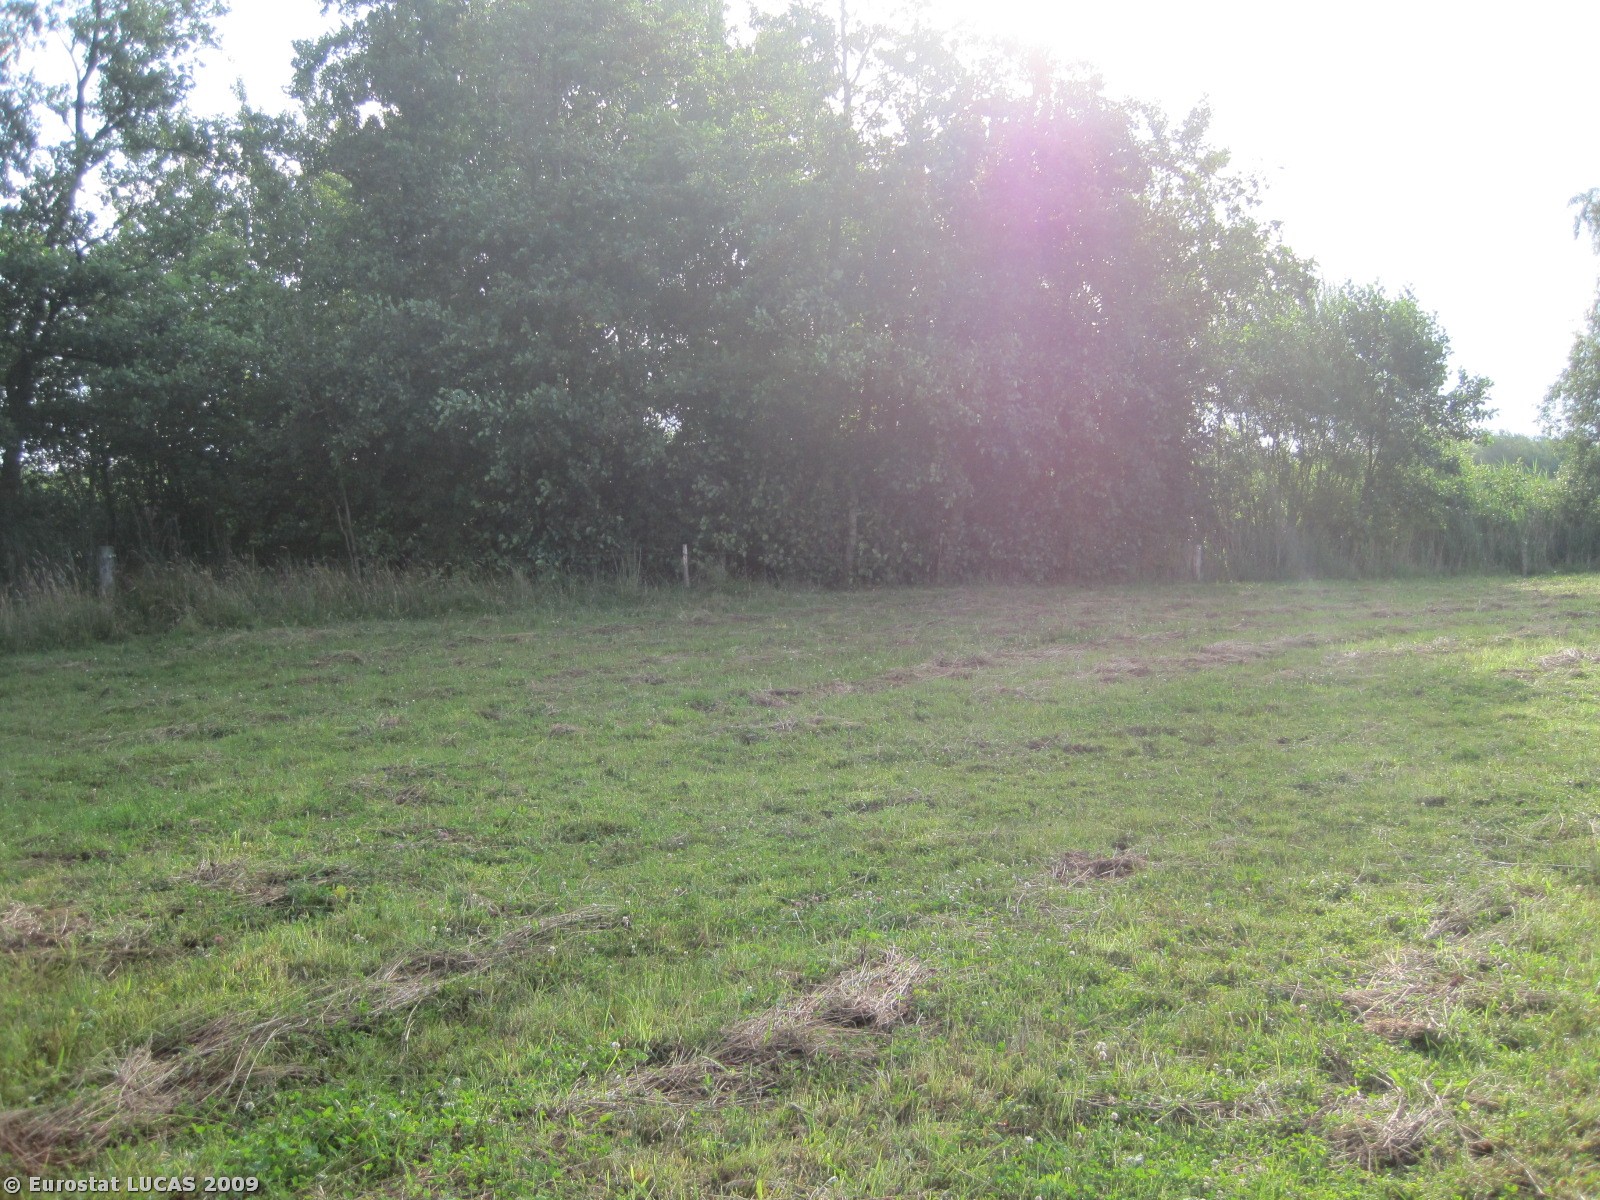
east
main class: Grassland
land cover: Grassland without tree/shrub cover
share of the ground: > 75 %
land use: Agriculture (excluding fallow land and kitchen gardens)
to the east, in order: Grassland without tree/shrub cover; Fences; Grass margins; Broadleaved woodland; Grass margins; Inland water bodies; Grassland without tree/shrub cover; Fences; Grassland without tree/shrub cover; Inland water bodies; Grassland without tree/shrub cover; Broadleaved woodland; Grassland without tree/shrub cover
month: July
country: DK
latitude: 57.0463
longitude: 8.9302
